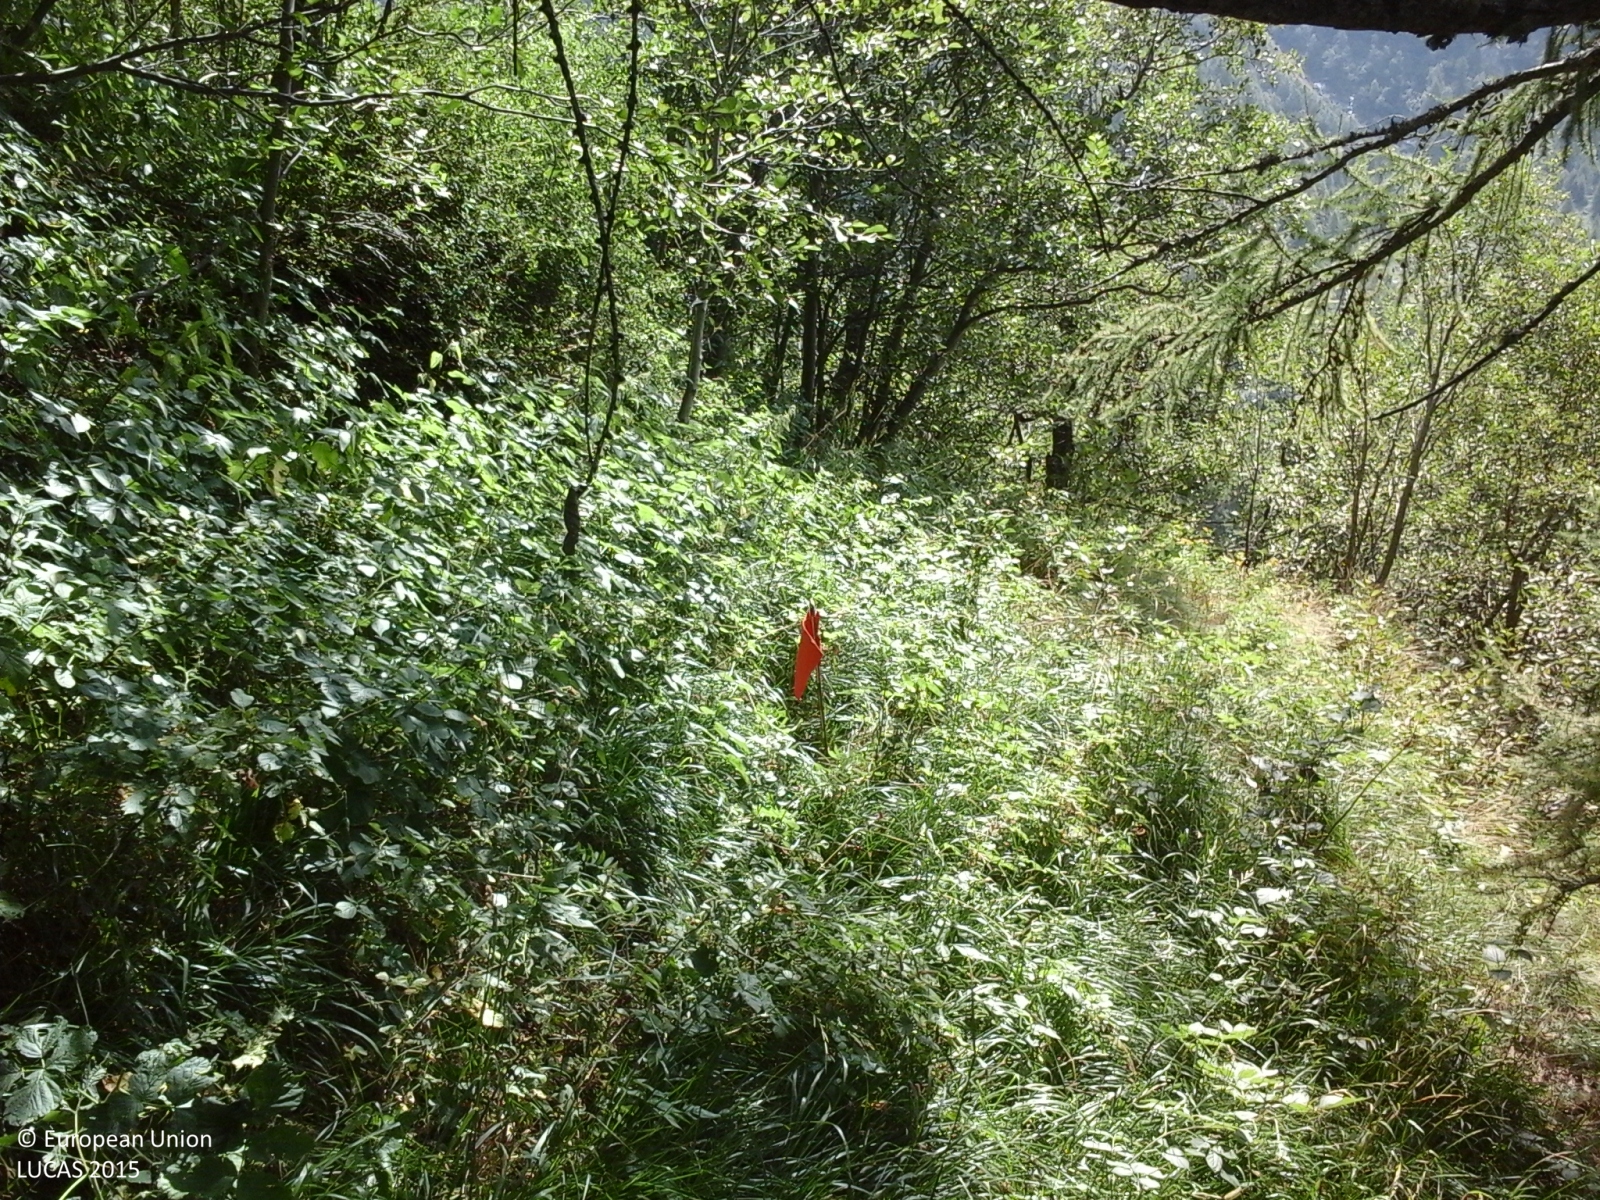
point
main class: Woodland
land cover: Other mixed woodland
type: mesophytic deciduous forest
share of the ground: > 75 %
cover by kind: broadleaved forest trees 75 %, coniferous forest trees 25 %
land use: Semi-natural and natural areas not in use
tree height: > 5 m
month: August
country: IT
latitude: 45.6789
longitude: 7.7566
